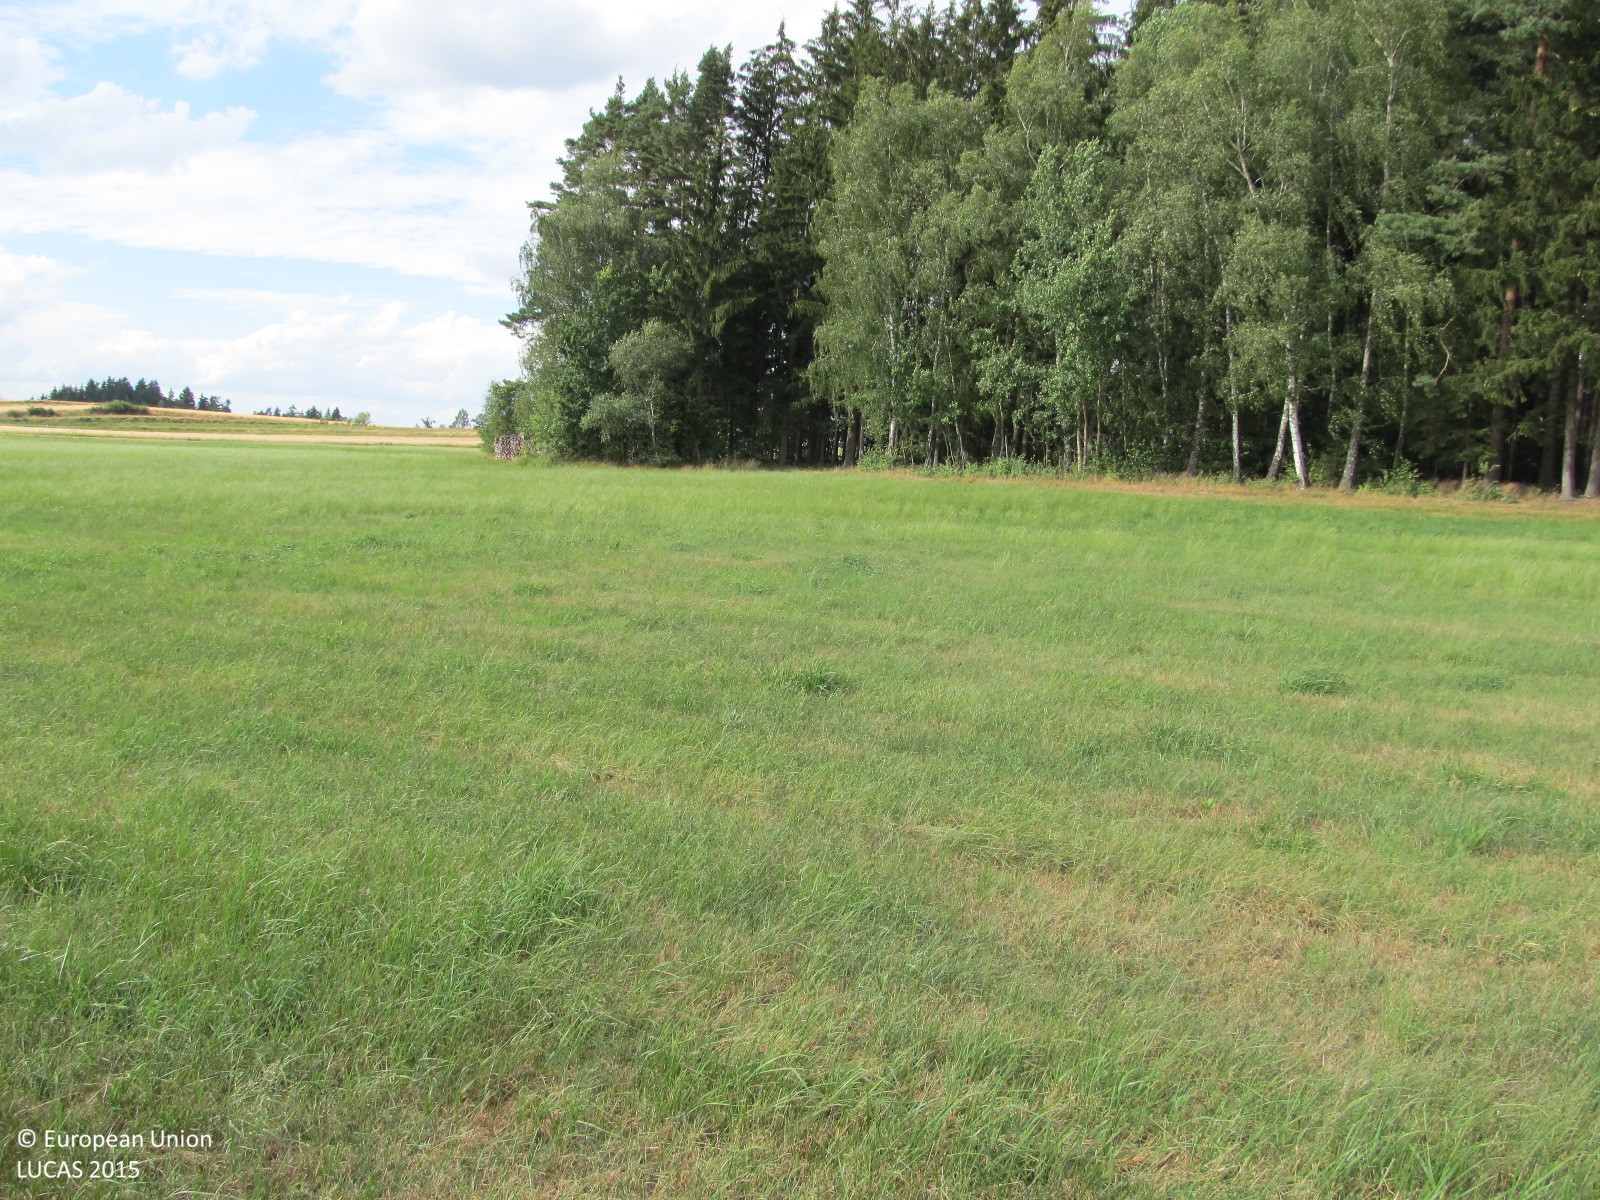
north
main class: Grassland
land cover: Grassland without tree/shrub cover
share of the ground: > 75 %
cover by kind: herbaceous plants 100 %
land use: Agriculture (excluding fallow land and kitchen gardens)
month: July
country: AT
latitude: 48.7031
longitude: 15.0431
